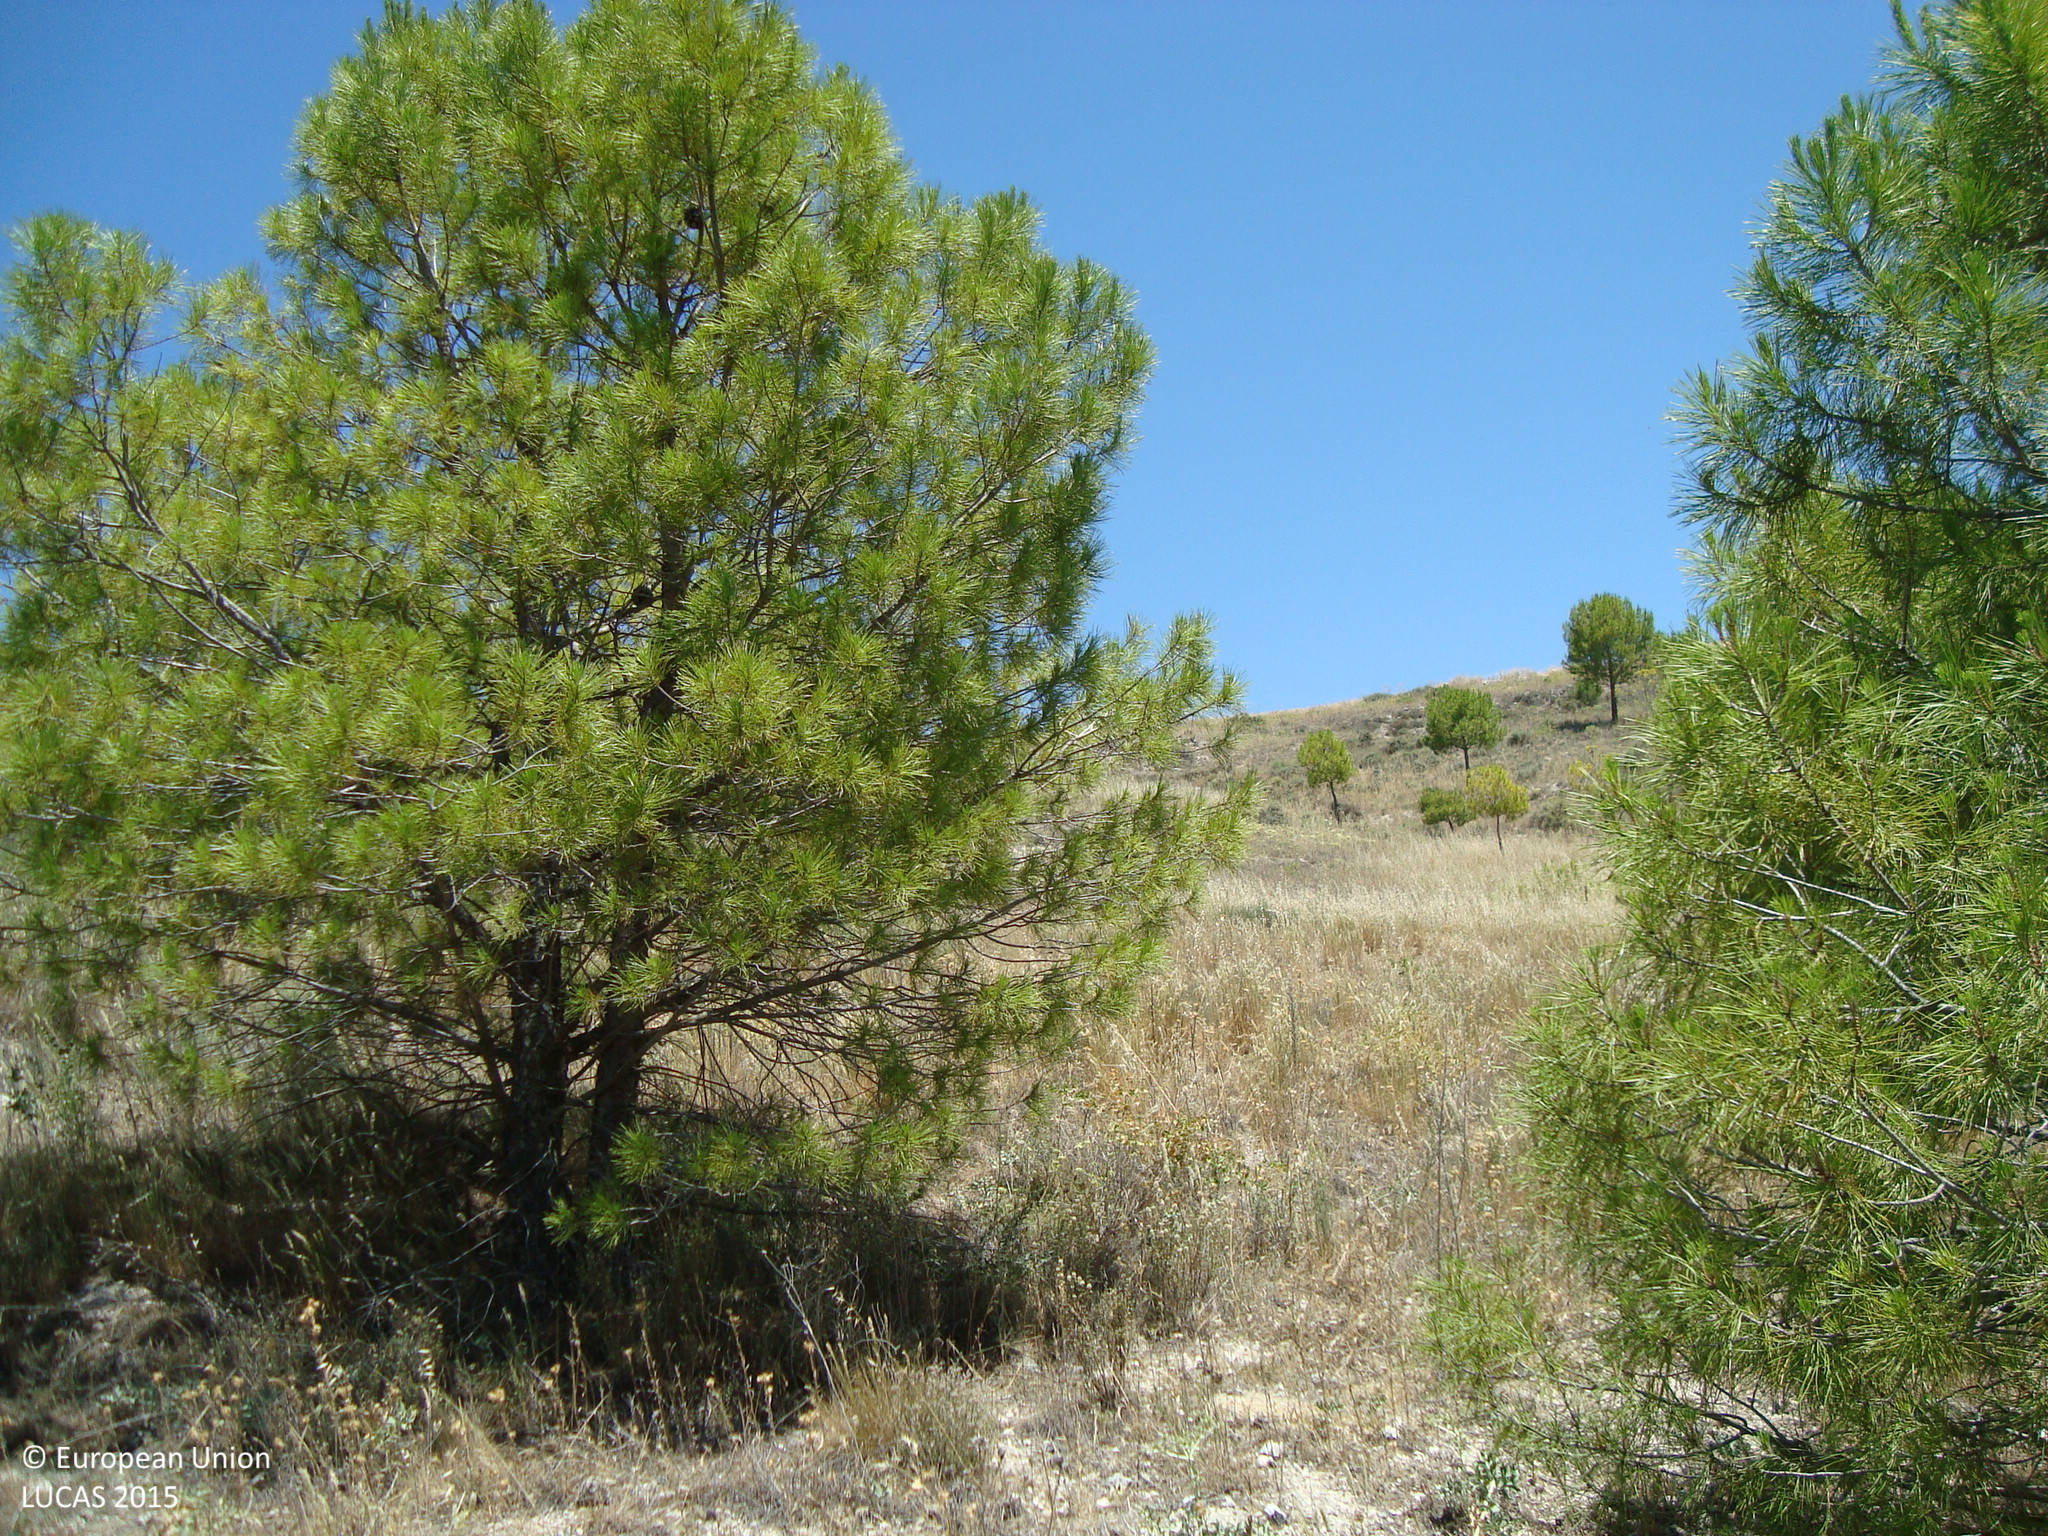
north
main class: Woodland
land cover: Pine dominated coniferous woodland
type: coniferous forest of the mediterranean region
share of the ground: 10 - 25 %
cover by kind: herbaceous plants 75 %, coniferous forest trees 15 %, shrubs 10 %
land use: Semi-natural and natural areas not in use
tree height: < 5 m
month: July
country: ES
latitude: 41.6590
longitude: -4.1216
